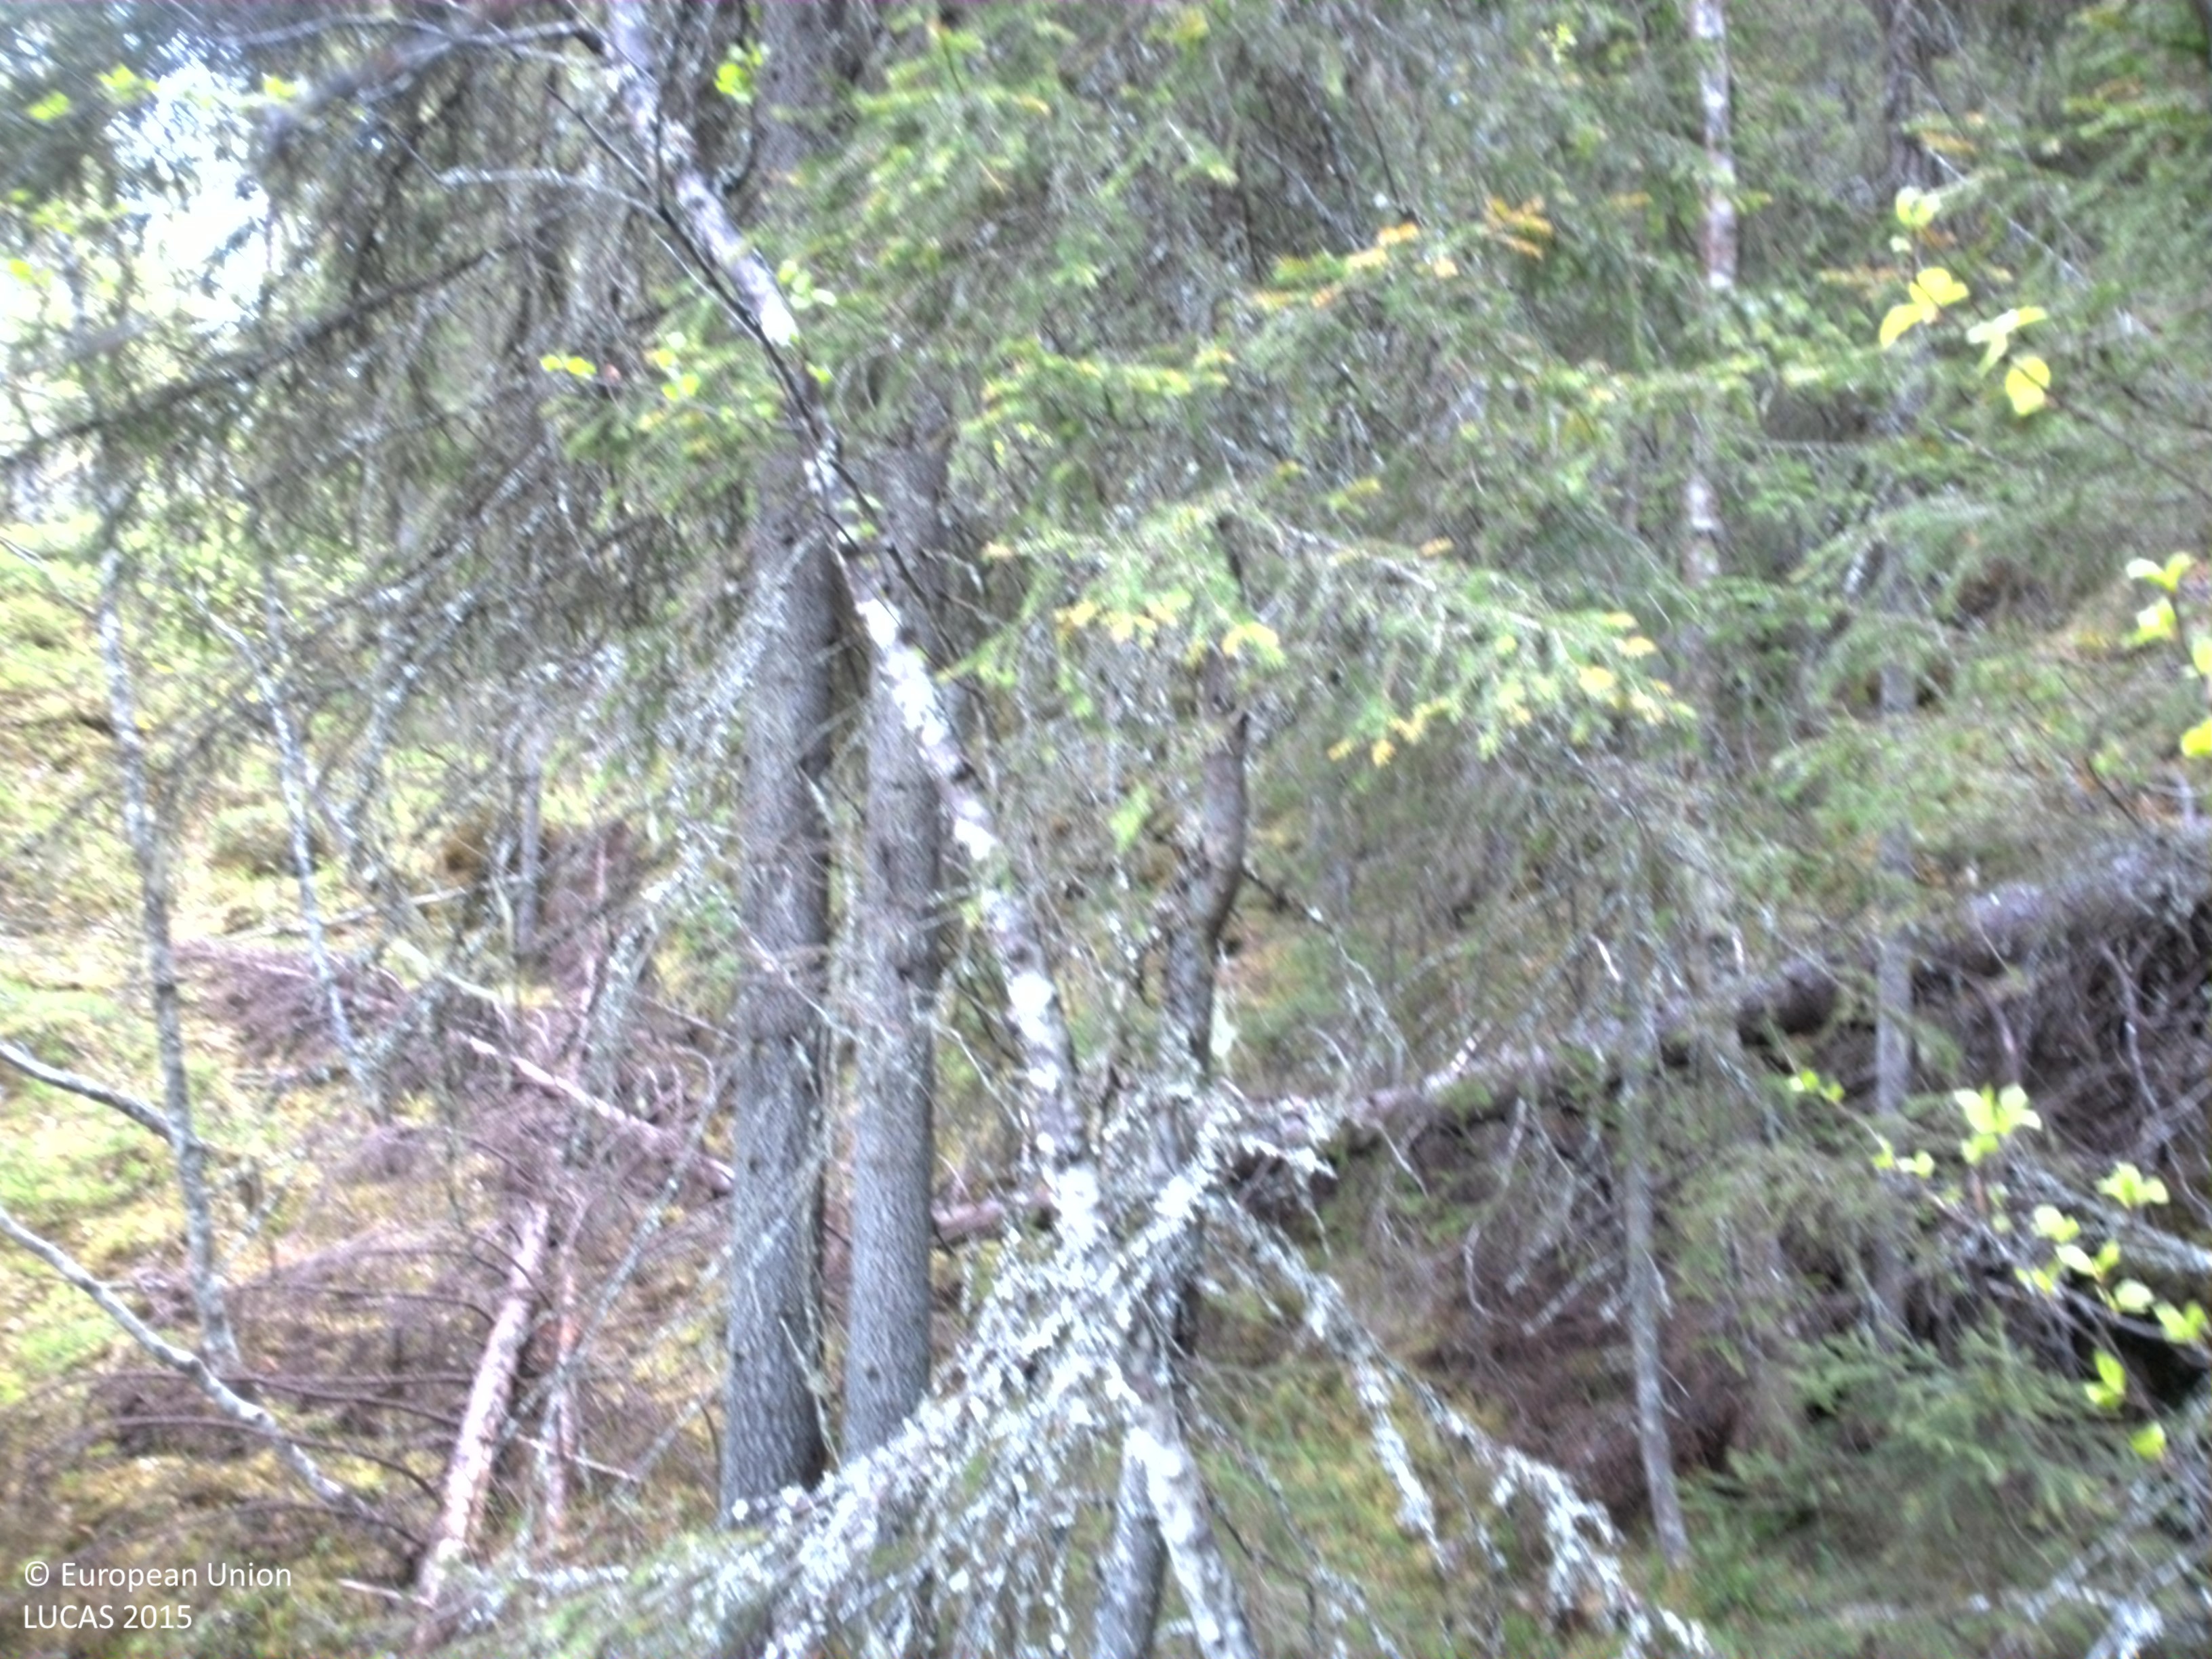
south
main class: Woodland
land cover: Spruce dominated mixed woodland
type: boreal forest
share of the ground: 50 - 75 %
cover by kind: coniferous forest trees 45 %, herbaceous plants 20 %, broadleaved forest trees 15 %, lichens and mosses 15 %, shrubs 5 %
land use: Forestry
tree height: > 5 m
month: June
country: SE
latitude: 64.2310
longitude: 18.0305
